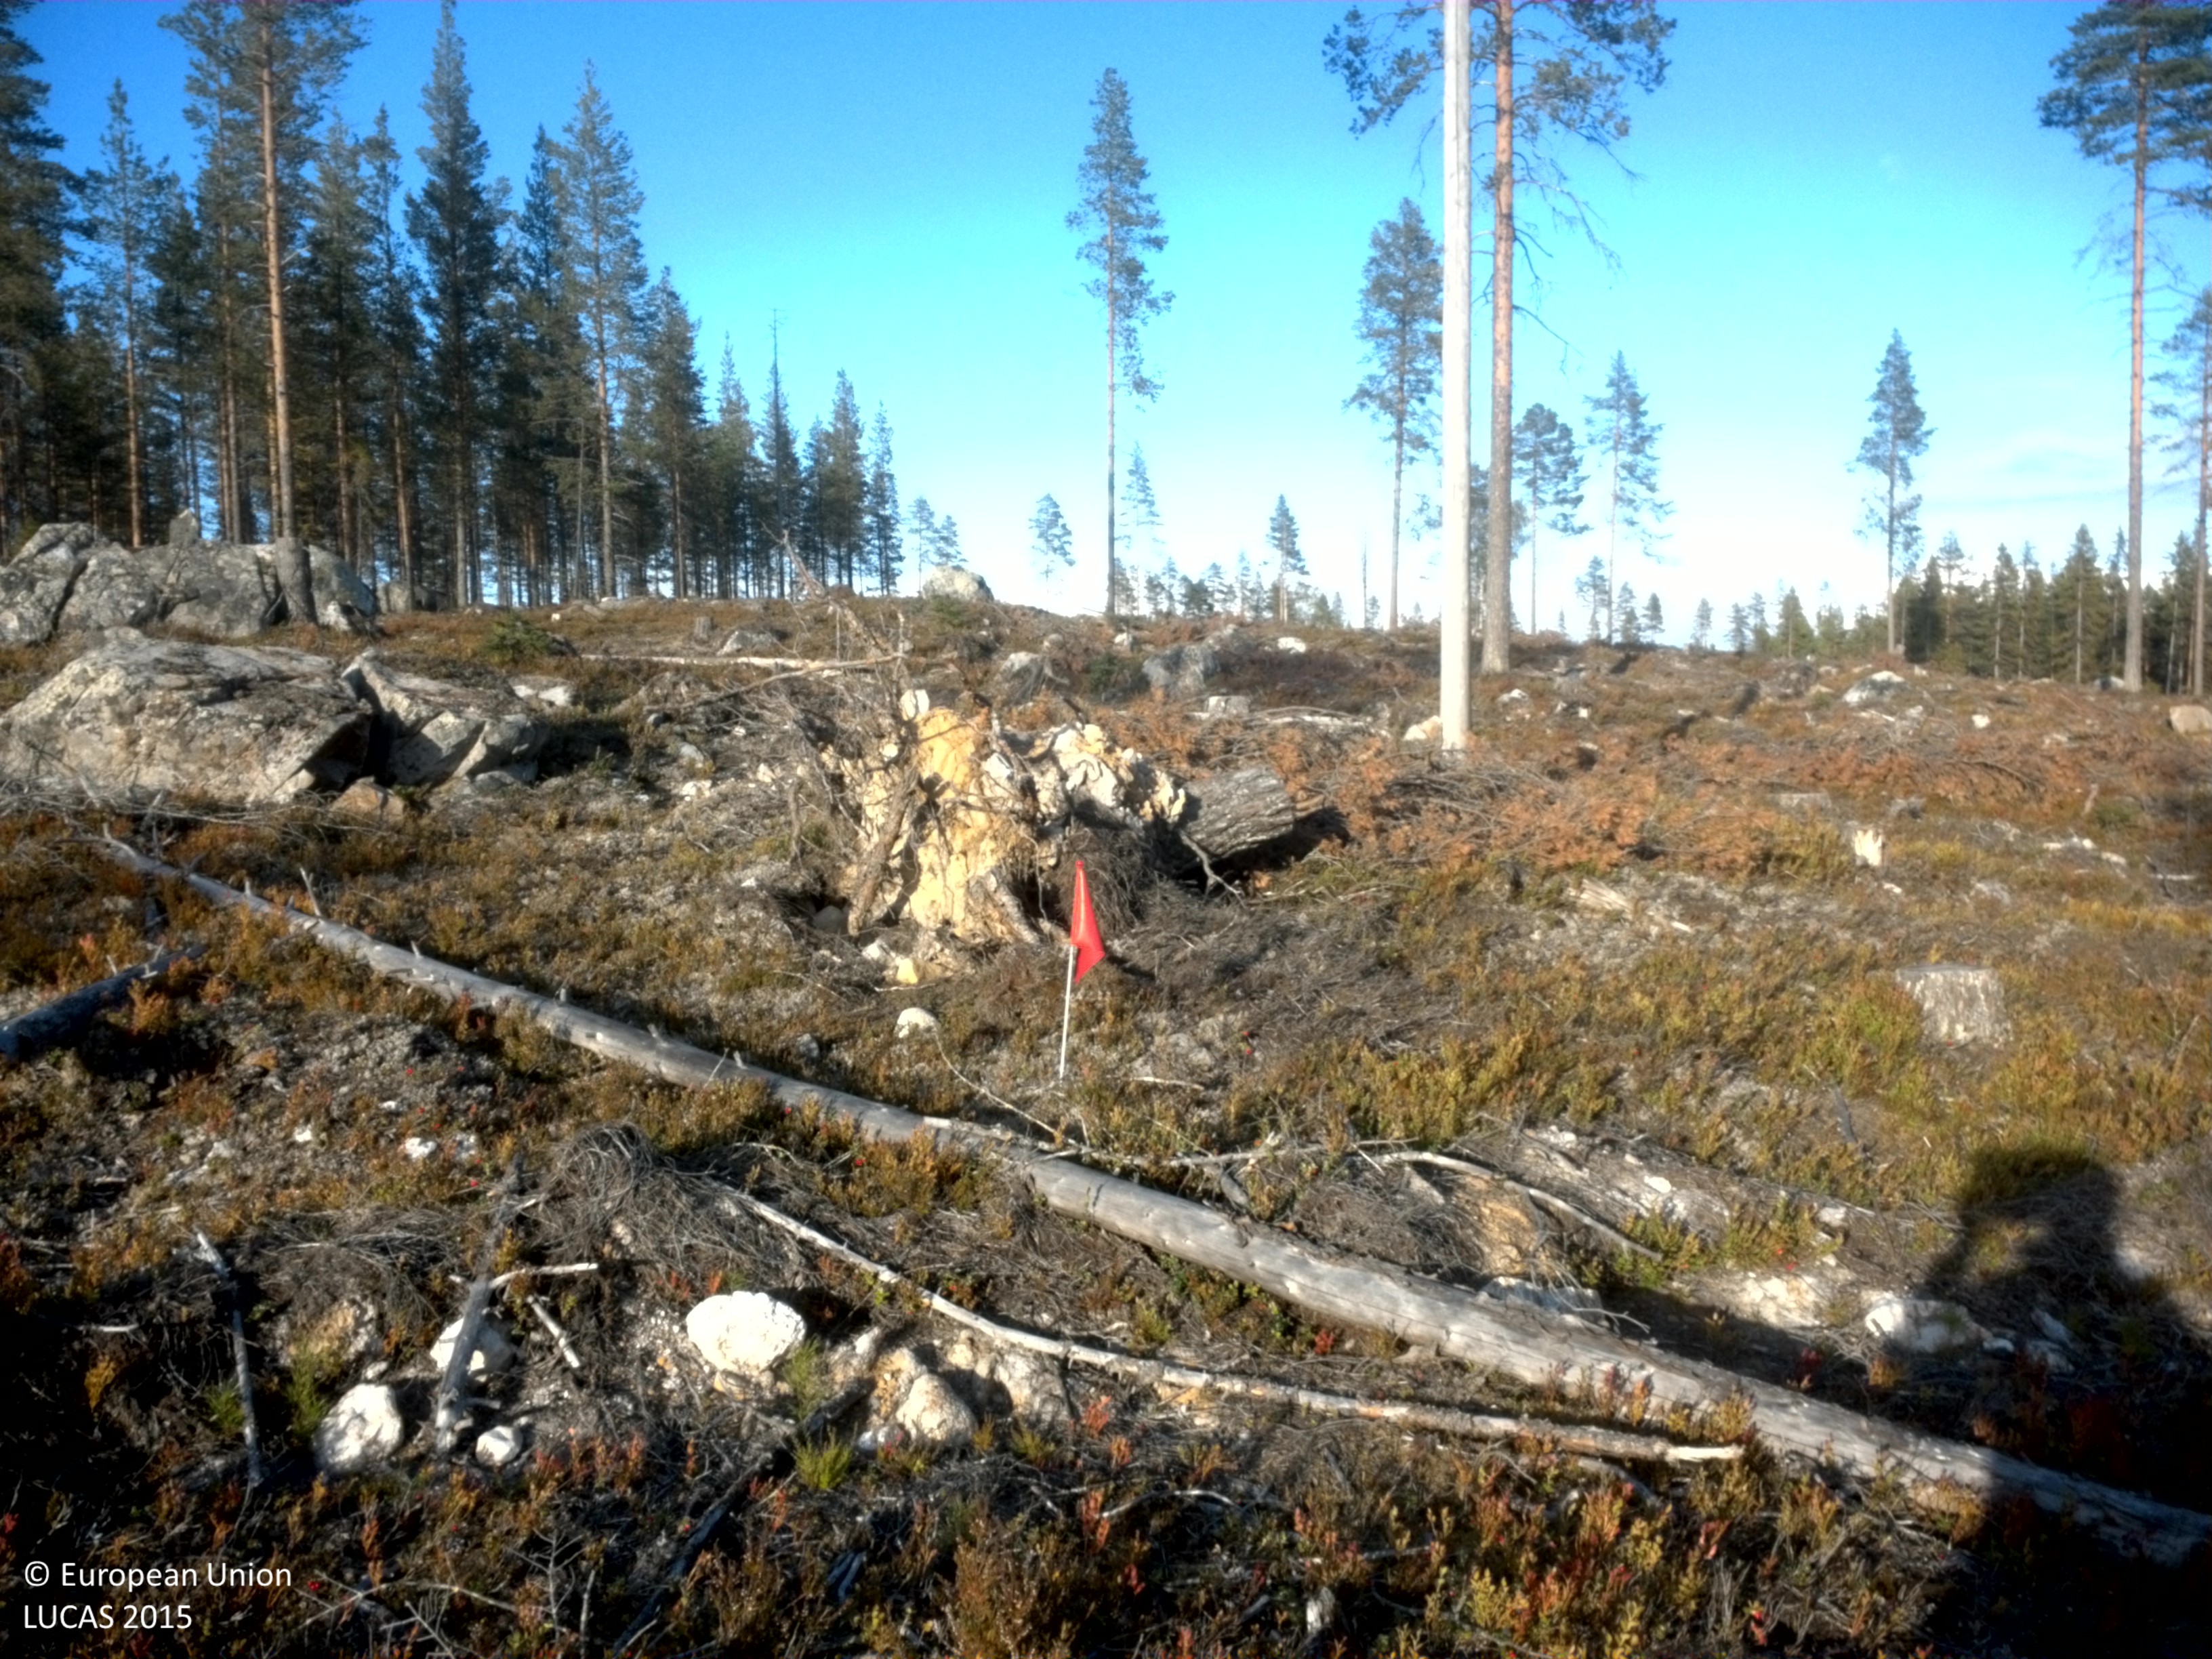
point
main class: Woodland
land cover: Pine dominated coniferous woodland
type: boreal forest
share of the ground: 10 - 25 %
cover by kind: shrubs 75 %, lichens and mosses 15 %, coniferous forest trees 10 %
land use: Forestry
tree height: > 5 m
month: September
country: SE
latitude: 64.4458
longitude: 19.7177
